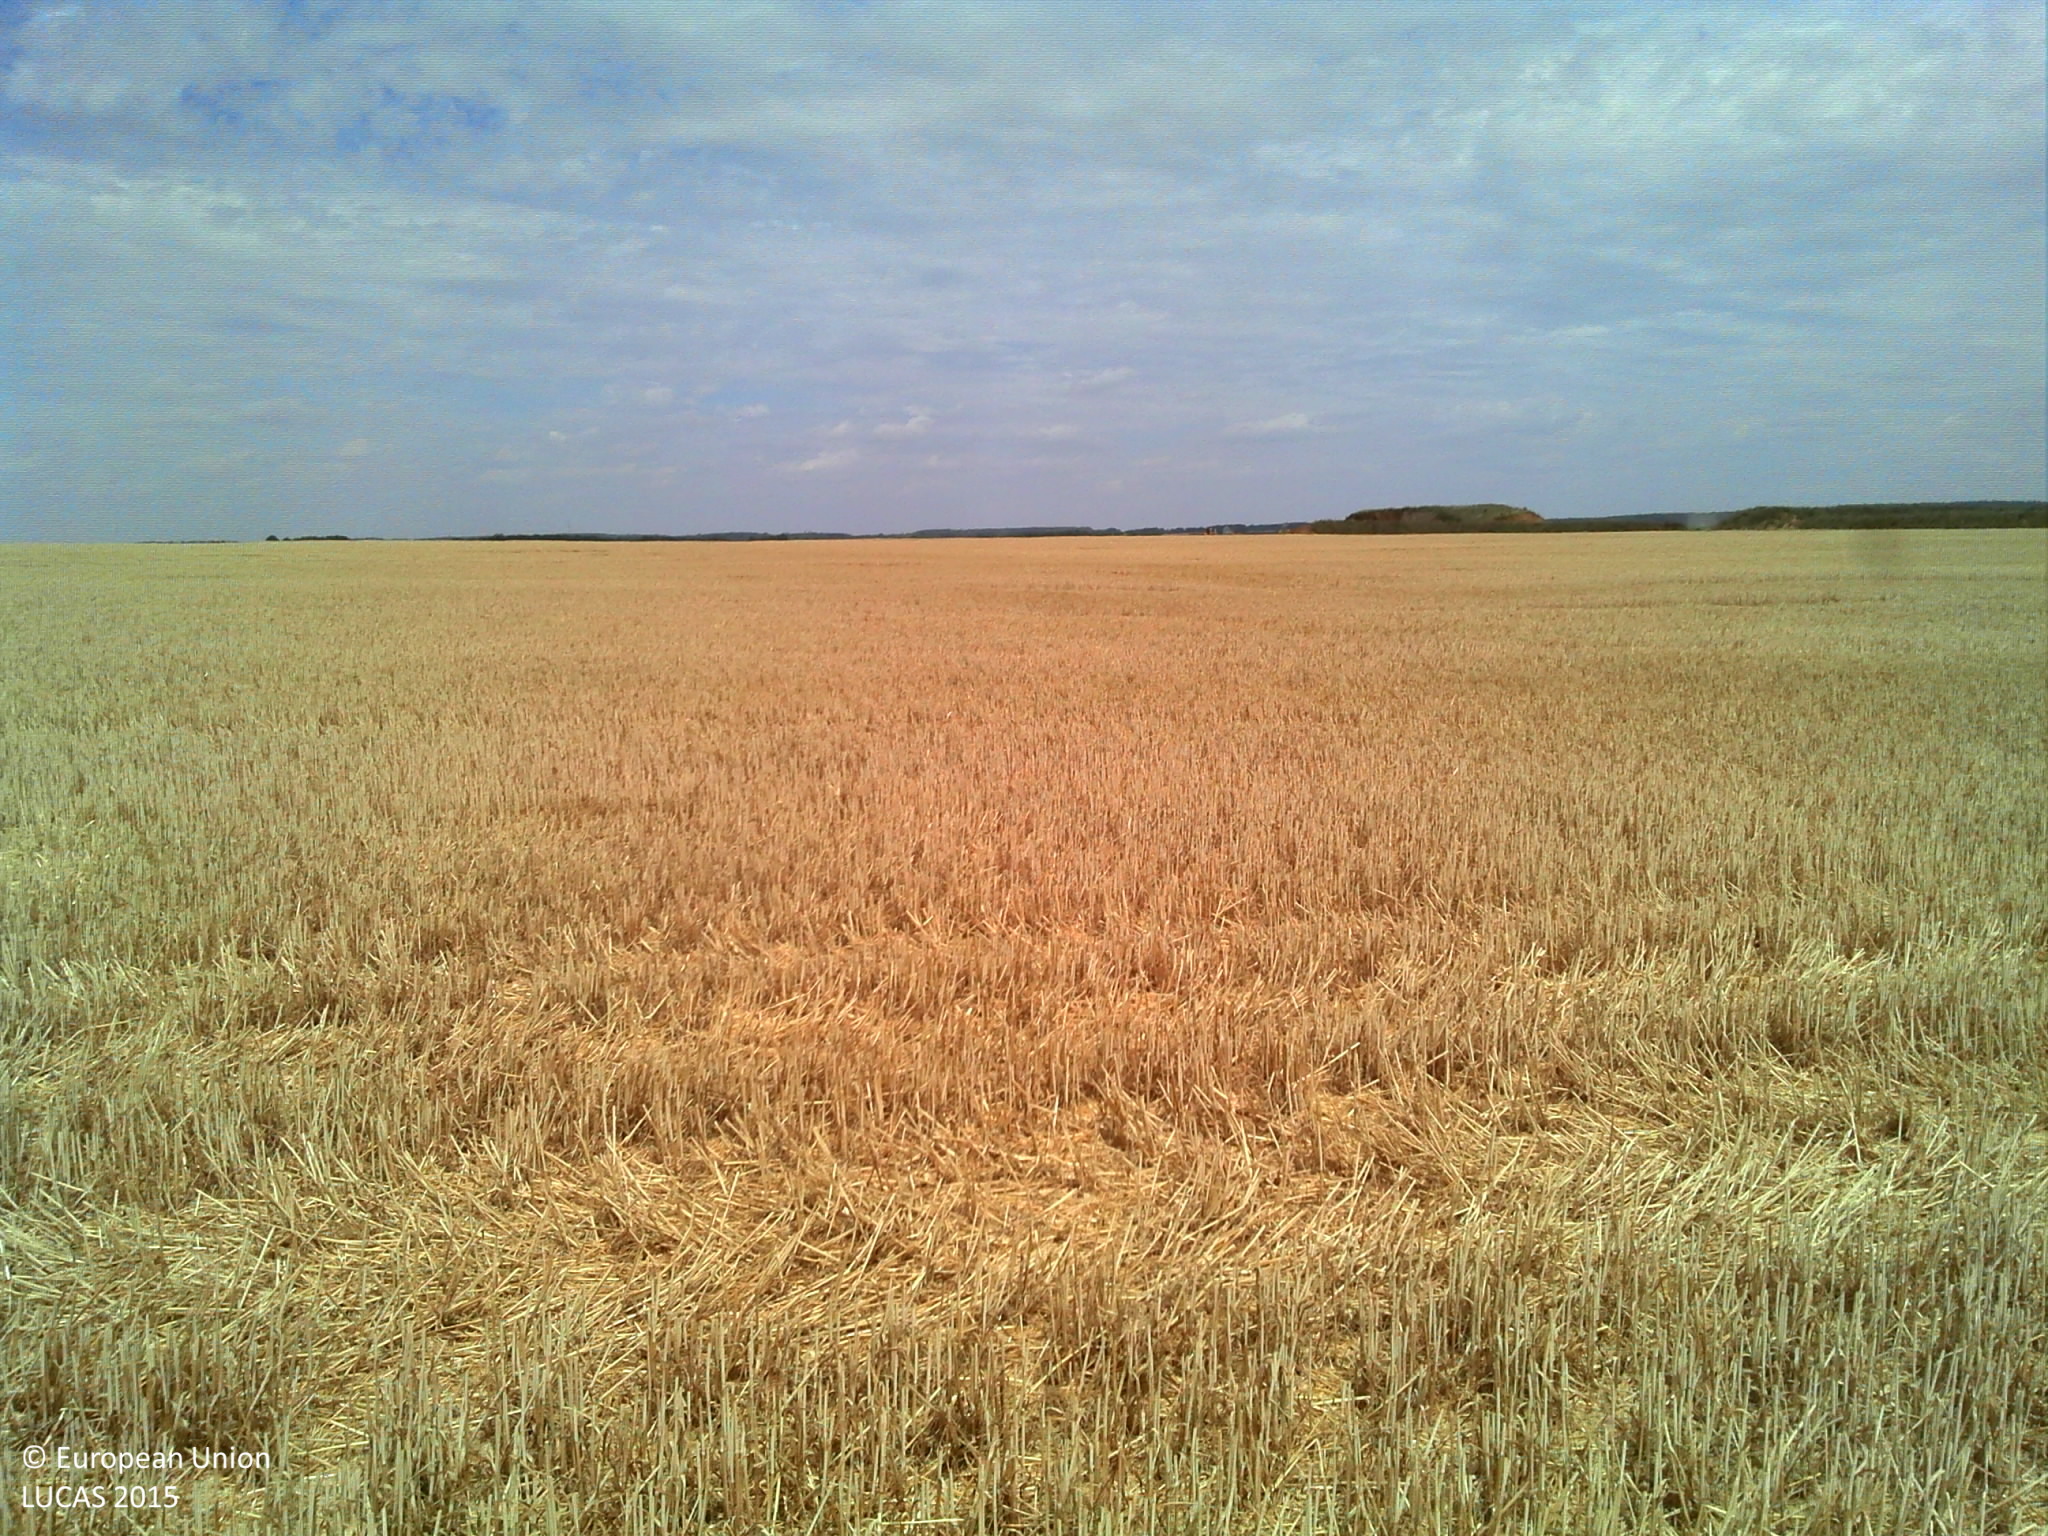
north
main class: Cropland
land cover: Common wheat
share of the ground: > 75 %
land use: Agriculture (excluding fallow land and kitchen gardens)
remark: Harvested field
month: July
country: FR
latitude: 48.4550
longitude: 1.2600
